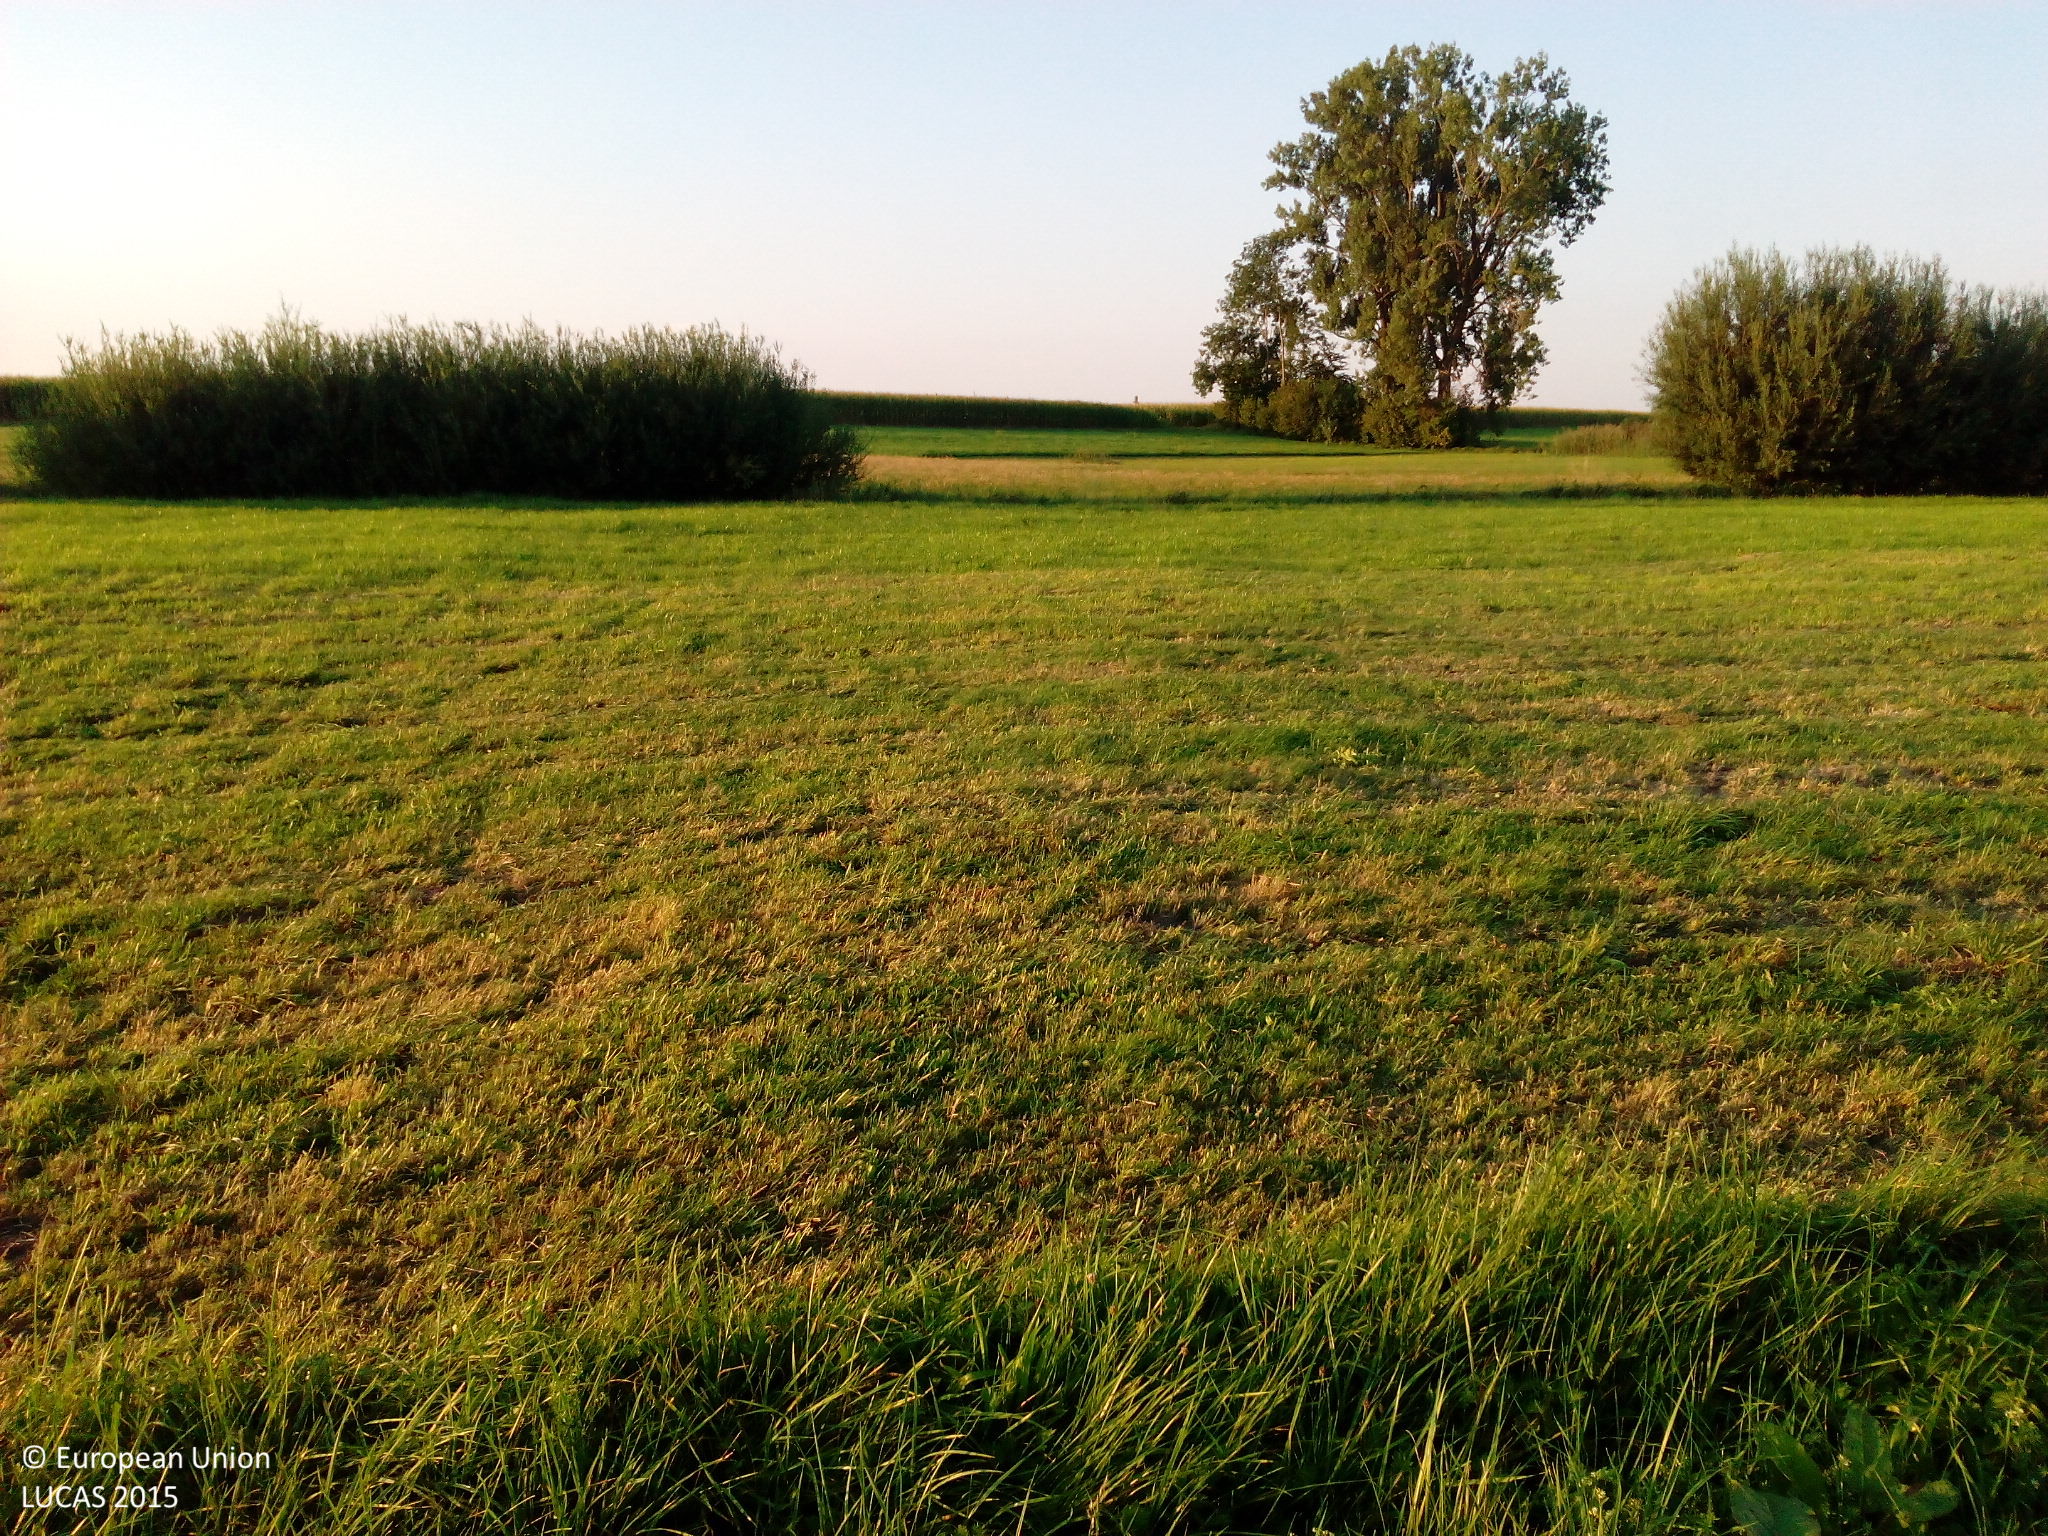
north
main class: Grassland
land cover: Grassland without tree/shrub cover
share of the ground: > 75 %
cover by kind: herbaceous plants 100 %
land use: Agriculture (excluding fallow land and kitchen gardens)
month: August
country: DE
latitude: 48.5290
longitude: 10.3113
